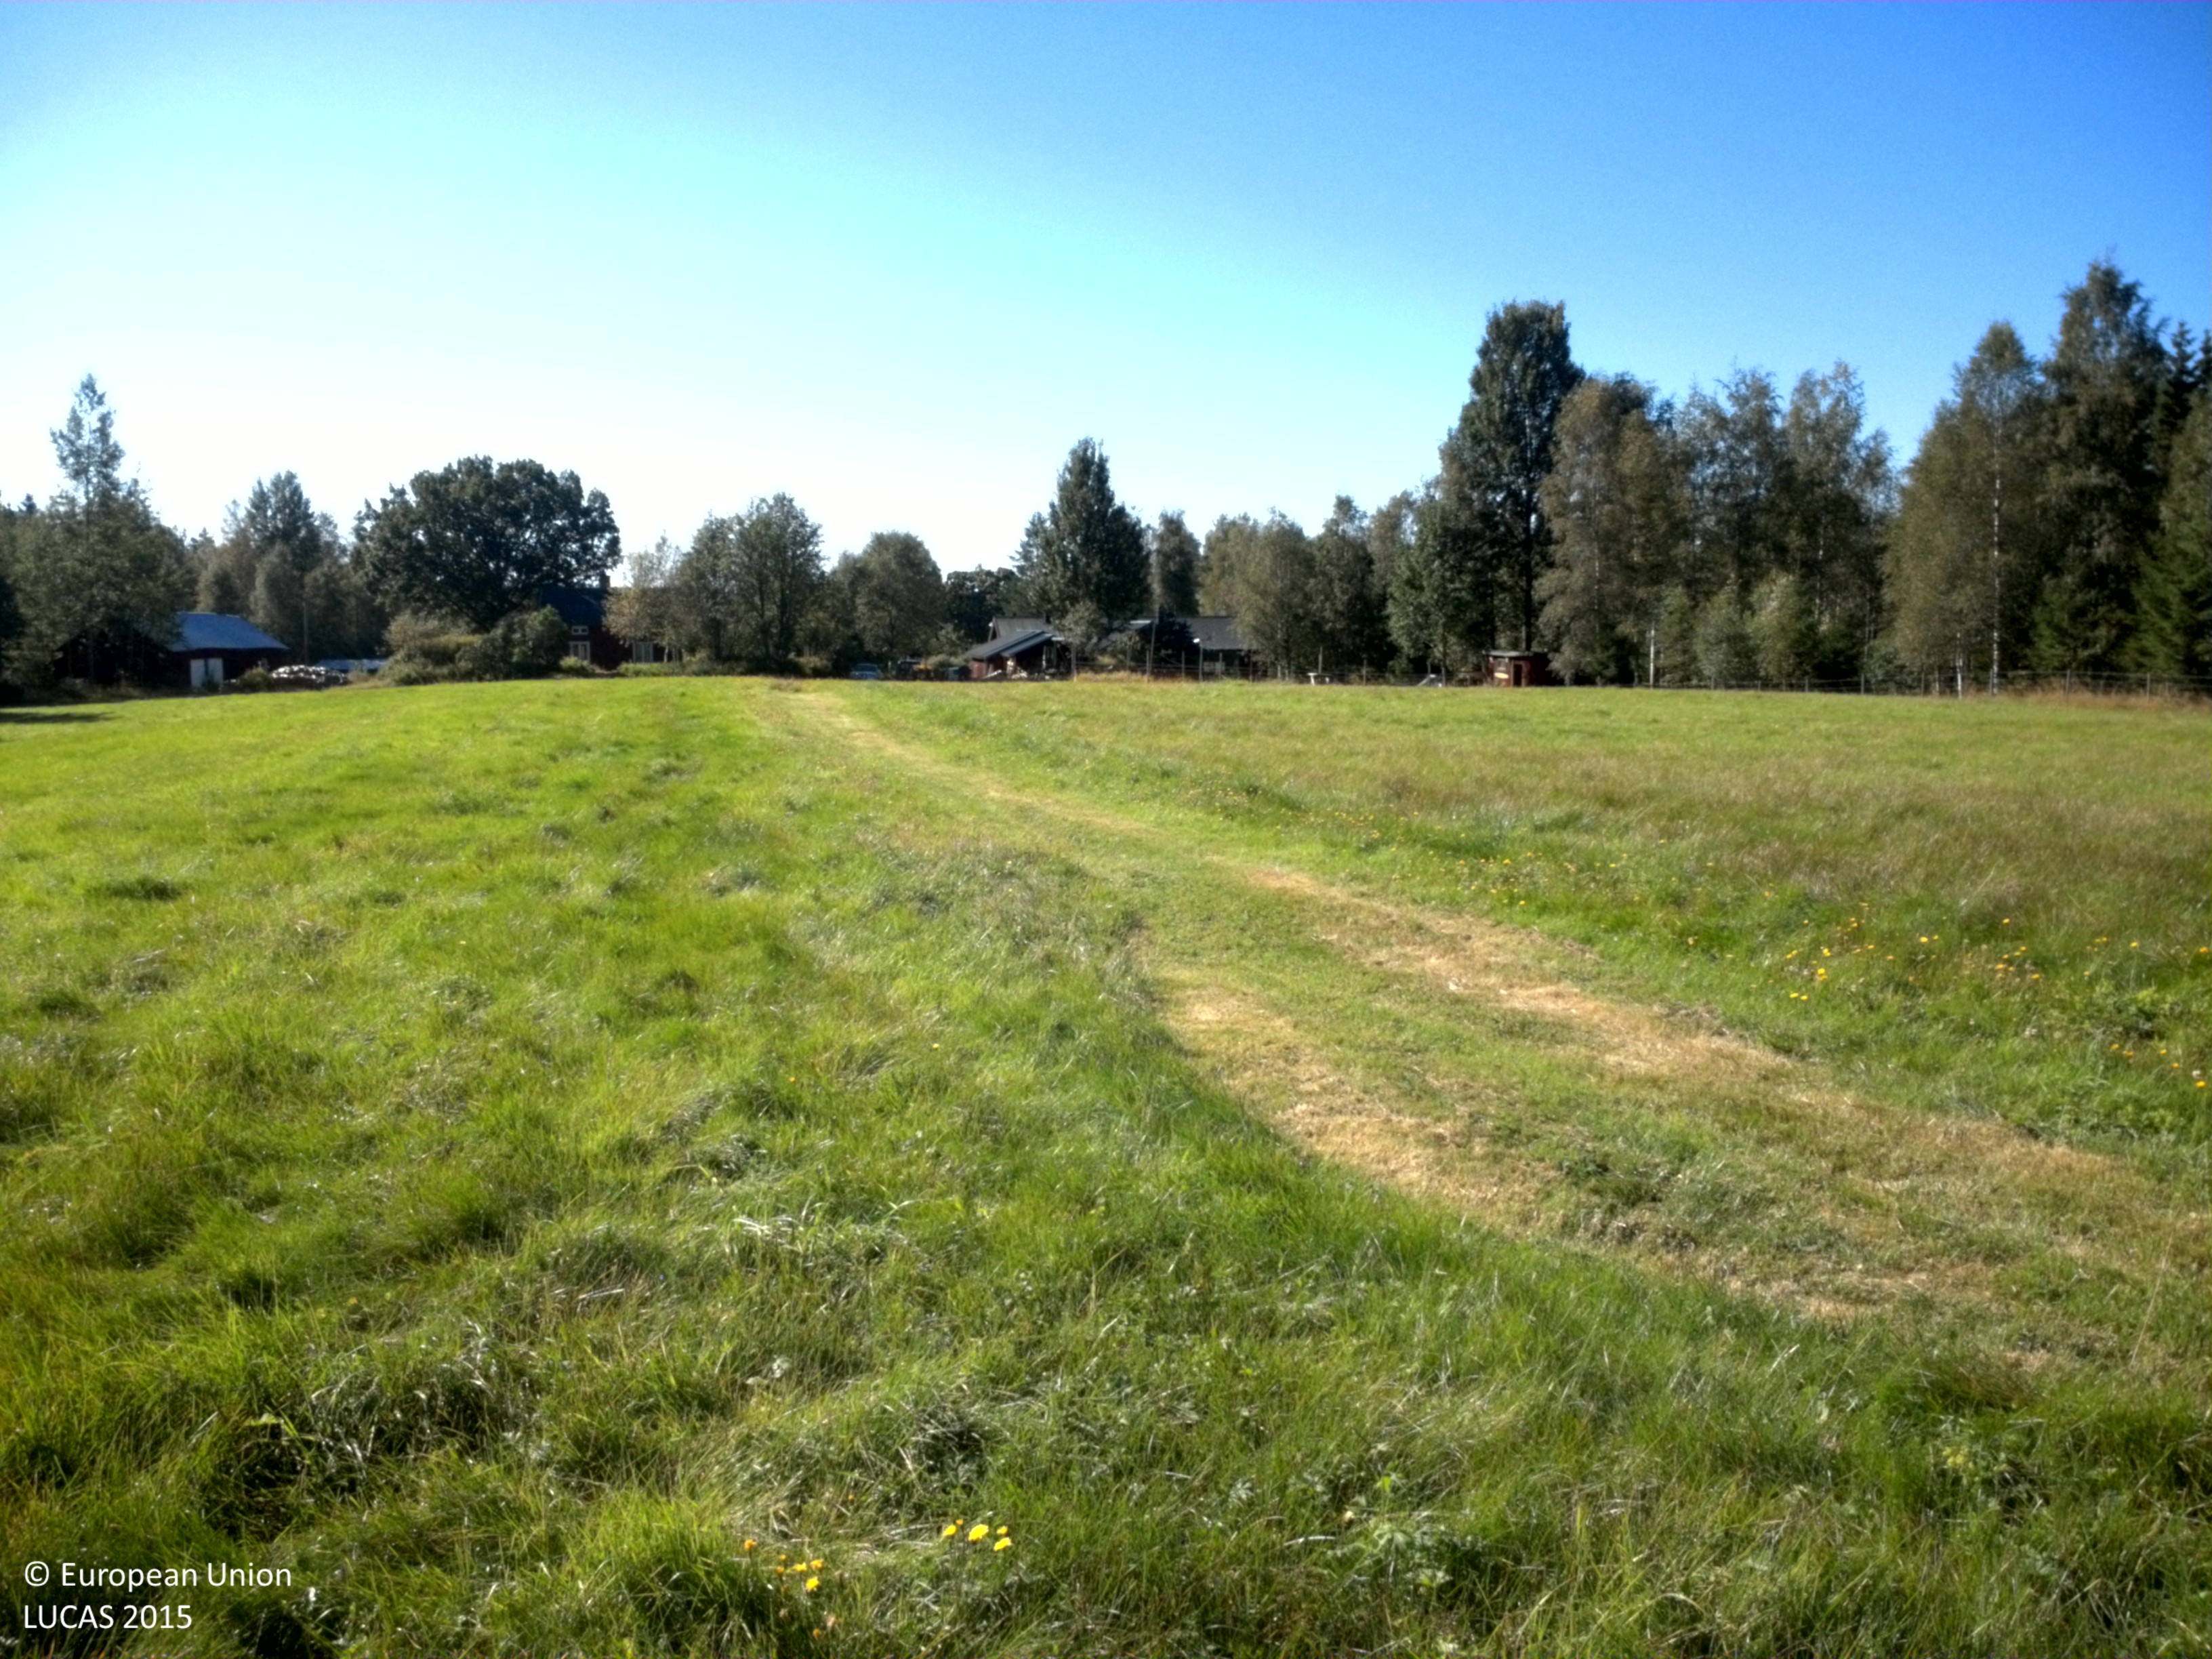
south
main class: Grassland
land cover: Grassland without tree/shrub cover
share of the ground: > 75 %
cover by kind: herbaceous plants 100 %
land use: Agriculture (excluding fallow land and kitchen gardens)
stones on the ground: < 10 %
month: August
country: SE
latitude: 59.8493
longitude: 14.1491
